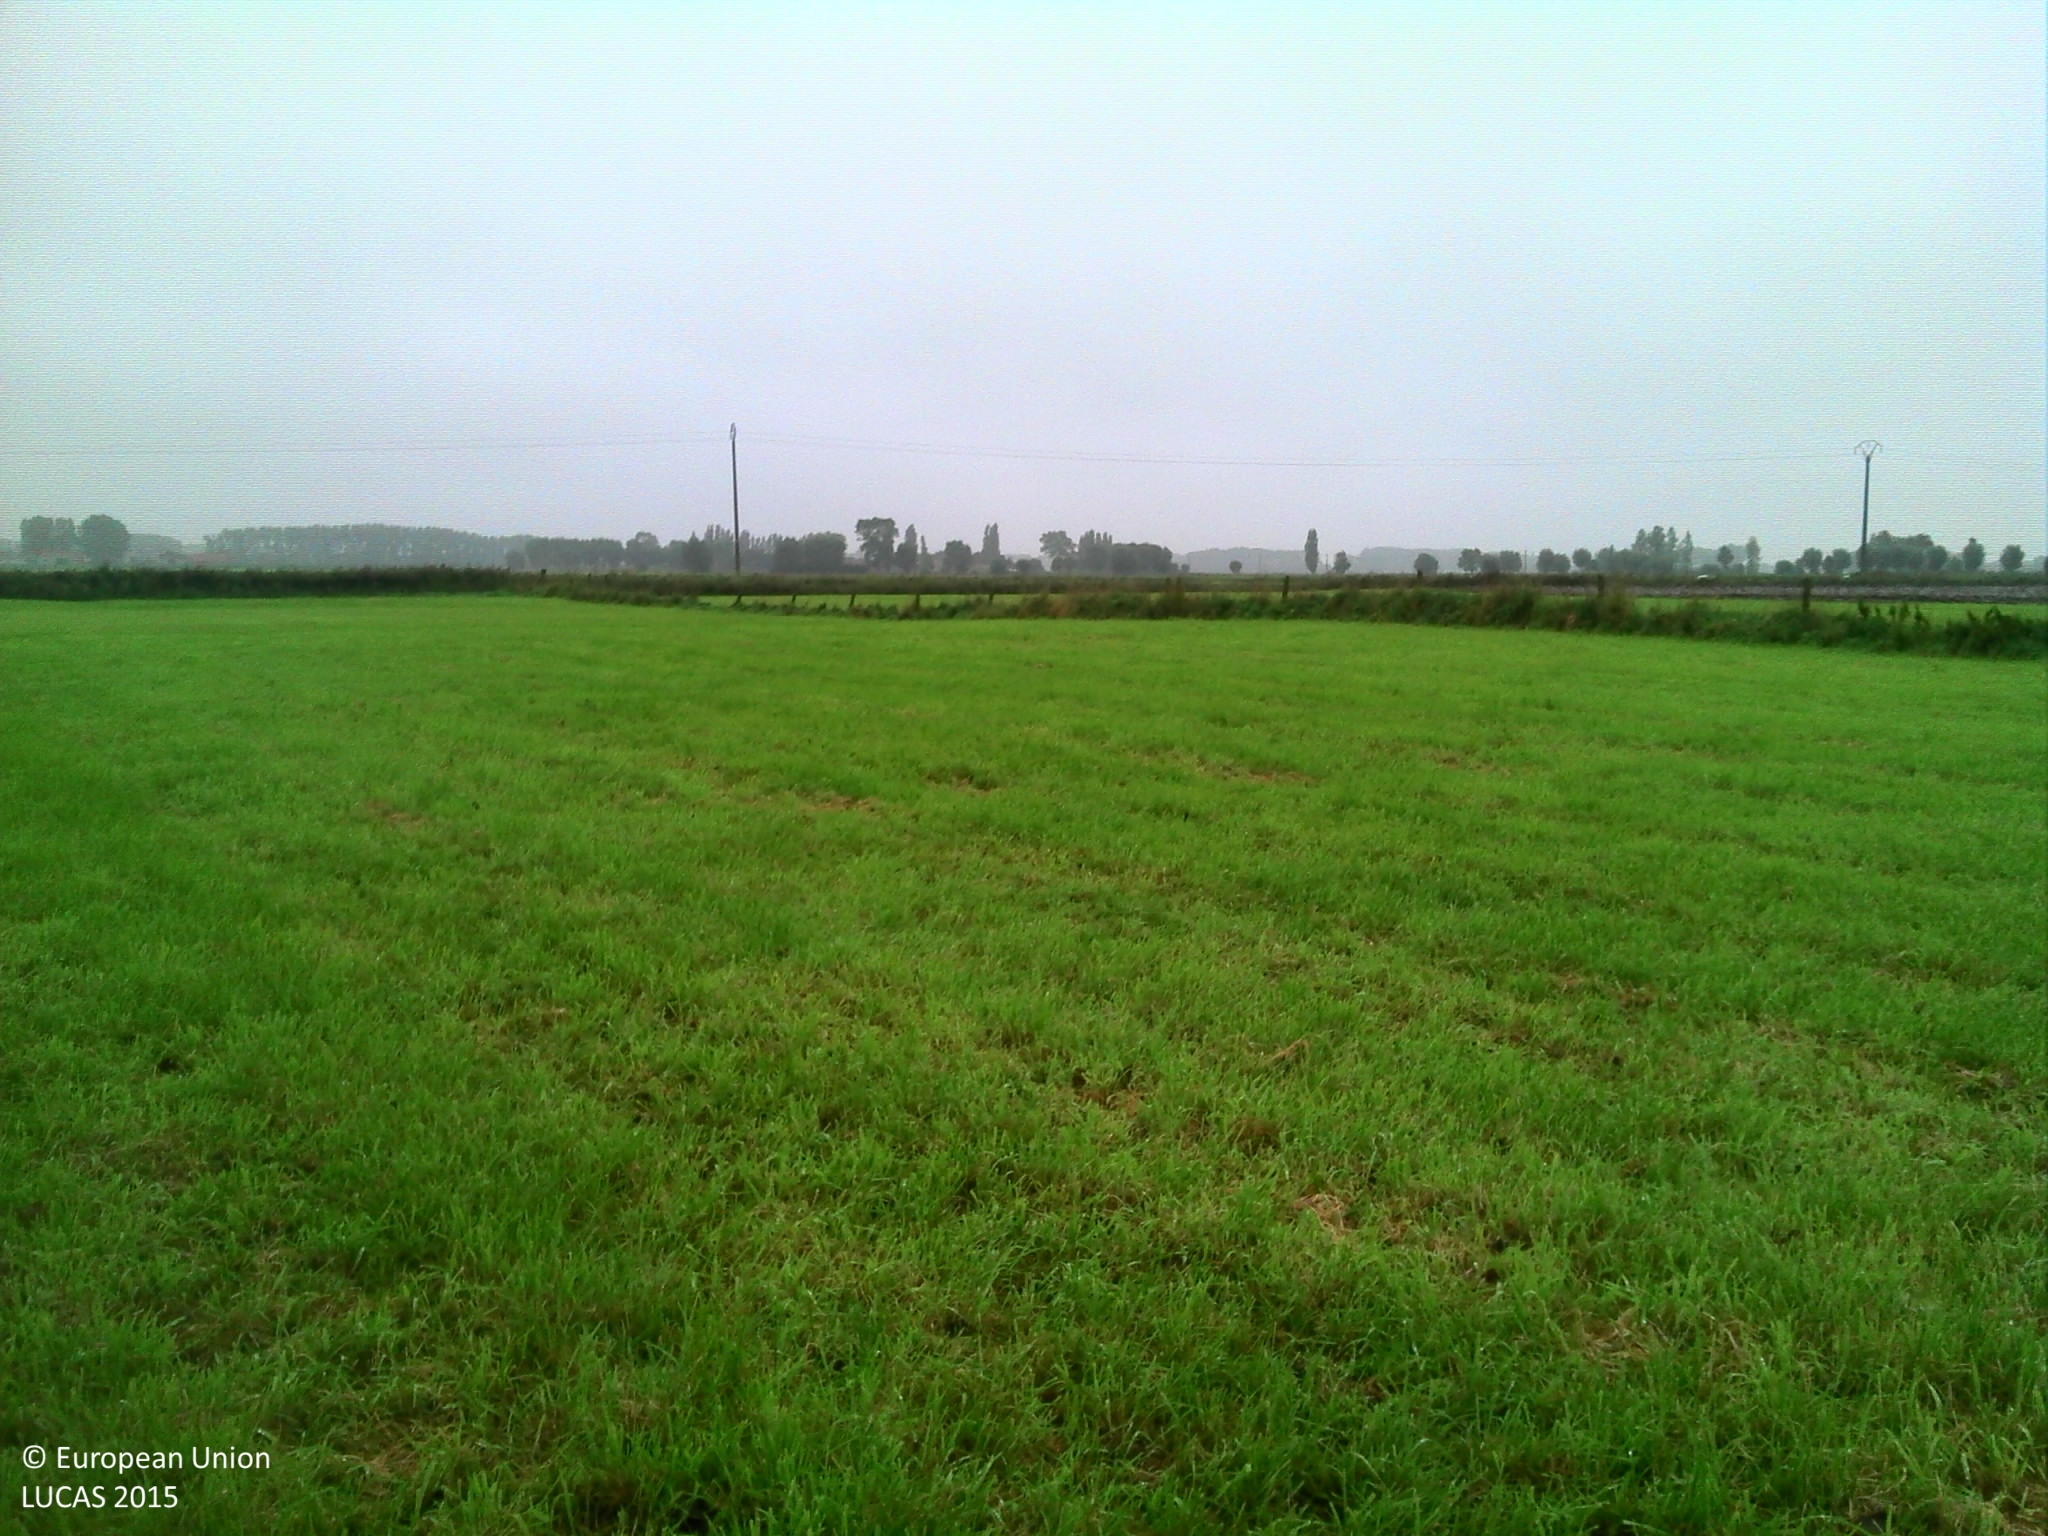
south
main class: Grassland
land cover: Grassland without tree/shrub cover
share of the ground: > 75 %
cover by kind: herbaceous plants 100 %
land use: Agriculture (excluding fallow land and kitchen gardens)
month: October
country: BE
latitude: 51.0066
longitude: 2.8490
